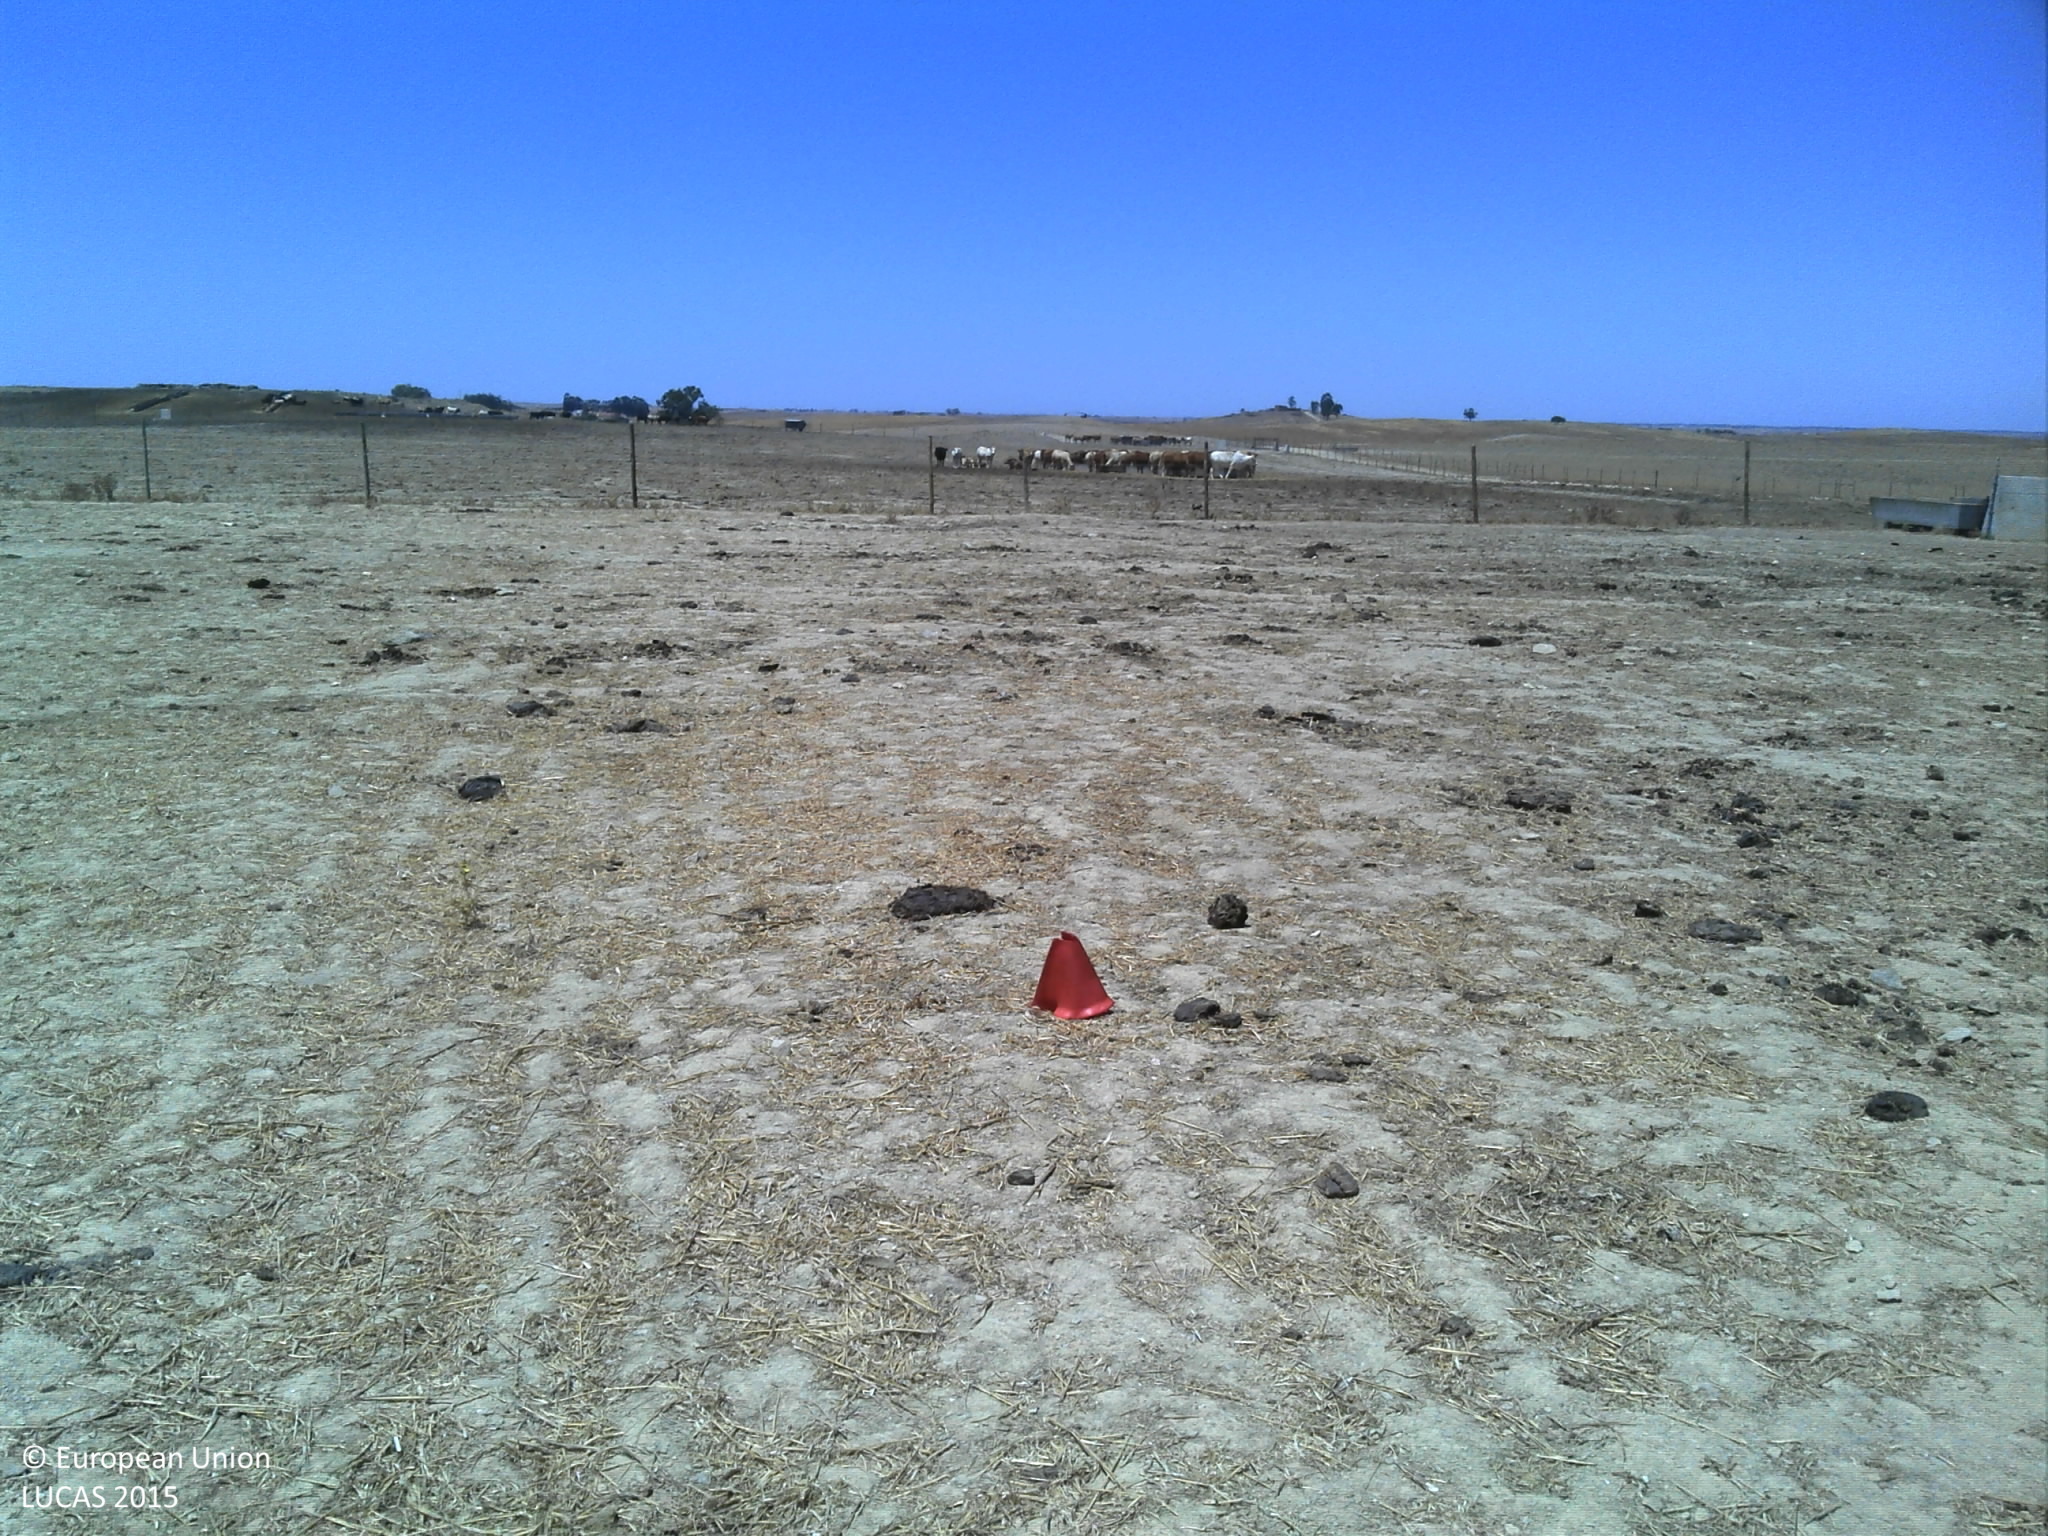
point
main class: Cropland
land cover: Mixed cereals for fodder
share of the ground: < 10 %
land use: Agriculture (excluding fallow land and kitchen gardens)
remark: Harvested field
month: July
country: PT
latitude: 37.6723
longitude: -7.9476
